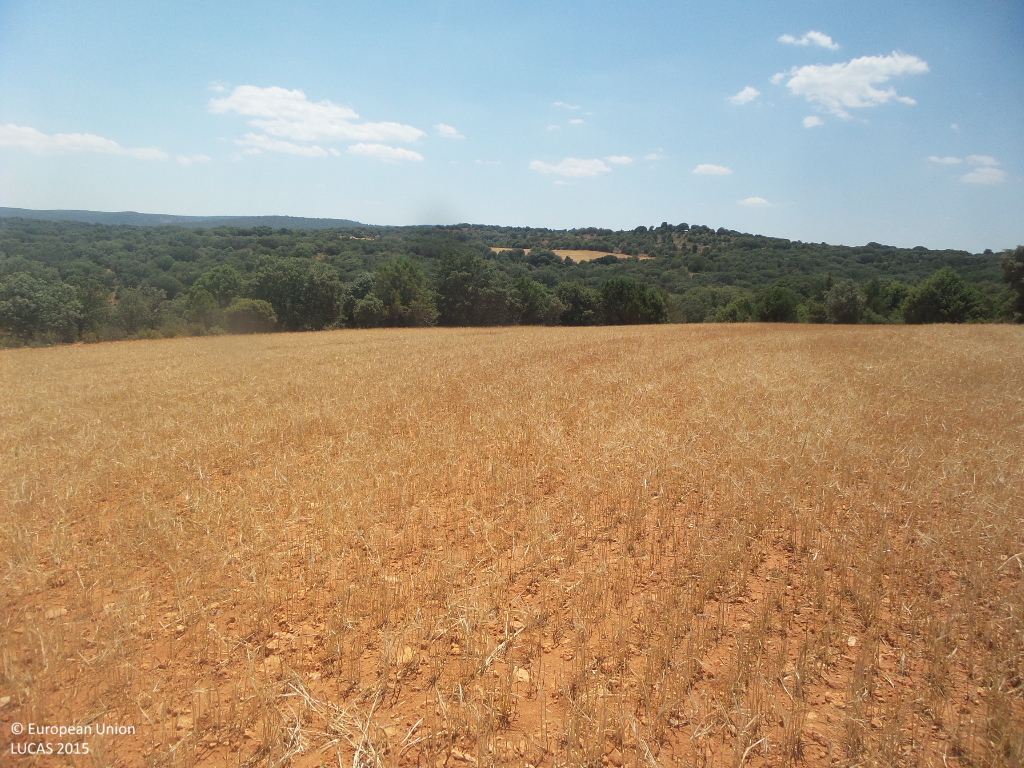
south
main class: Cropland
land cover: Barley
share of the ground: 50 - 75 %
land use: Agriculture (excluding fallow land and kitchen gardens)
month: July
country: ES
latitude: 41.1685
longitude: -2.1738
